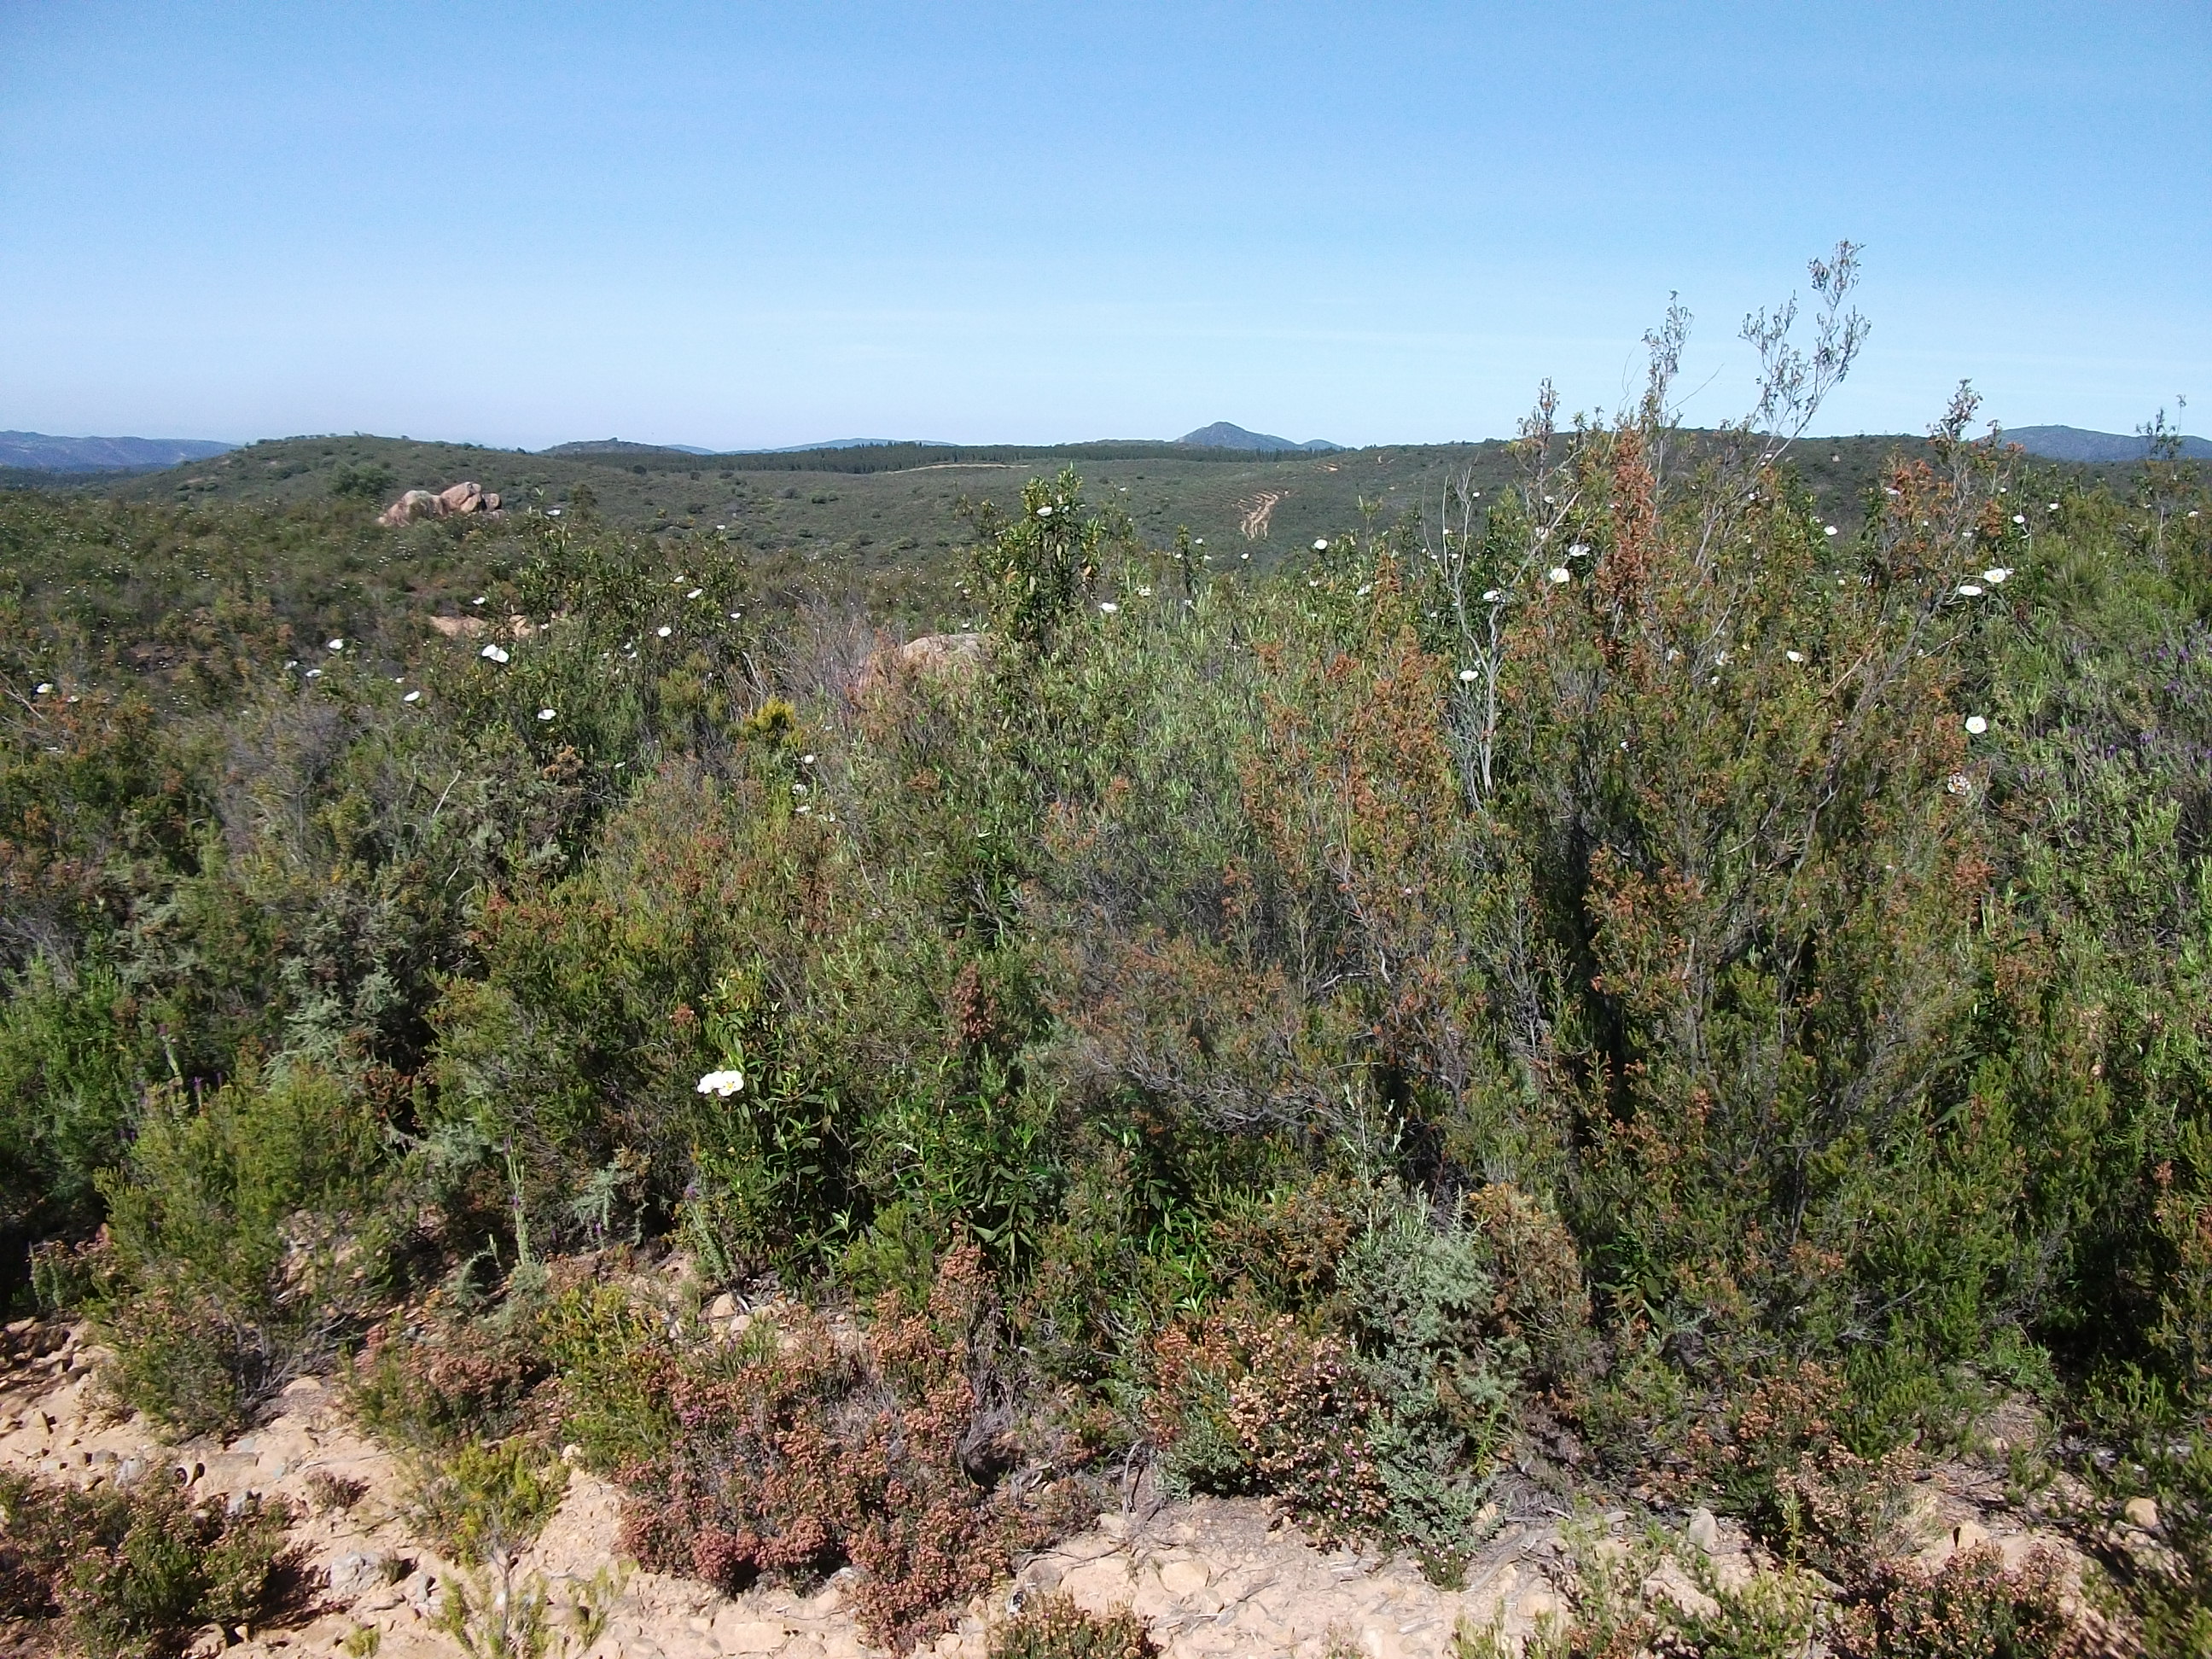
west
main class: Shrubland
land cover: Shrubland without tree cover
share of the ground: > 75 %
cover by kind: shrubs 95 %, unconsolidated bare surface 5 %
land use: Semi-natural and natural areas not in use
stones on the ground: 10 - 25 %
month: April
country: ES
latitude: 37.8501
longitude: -6.5787
